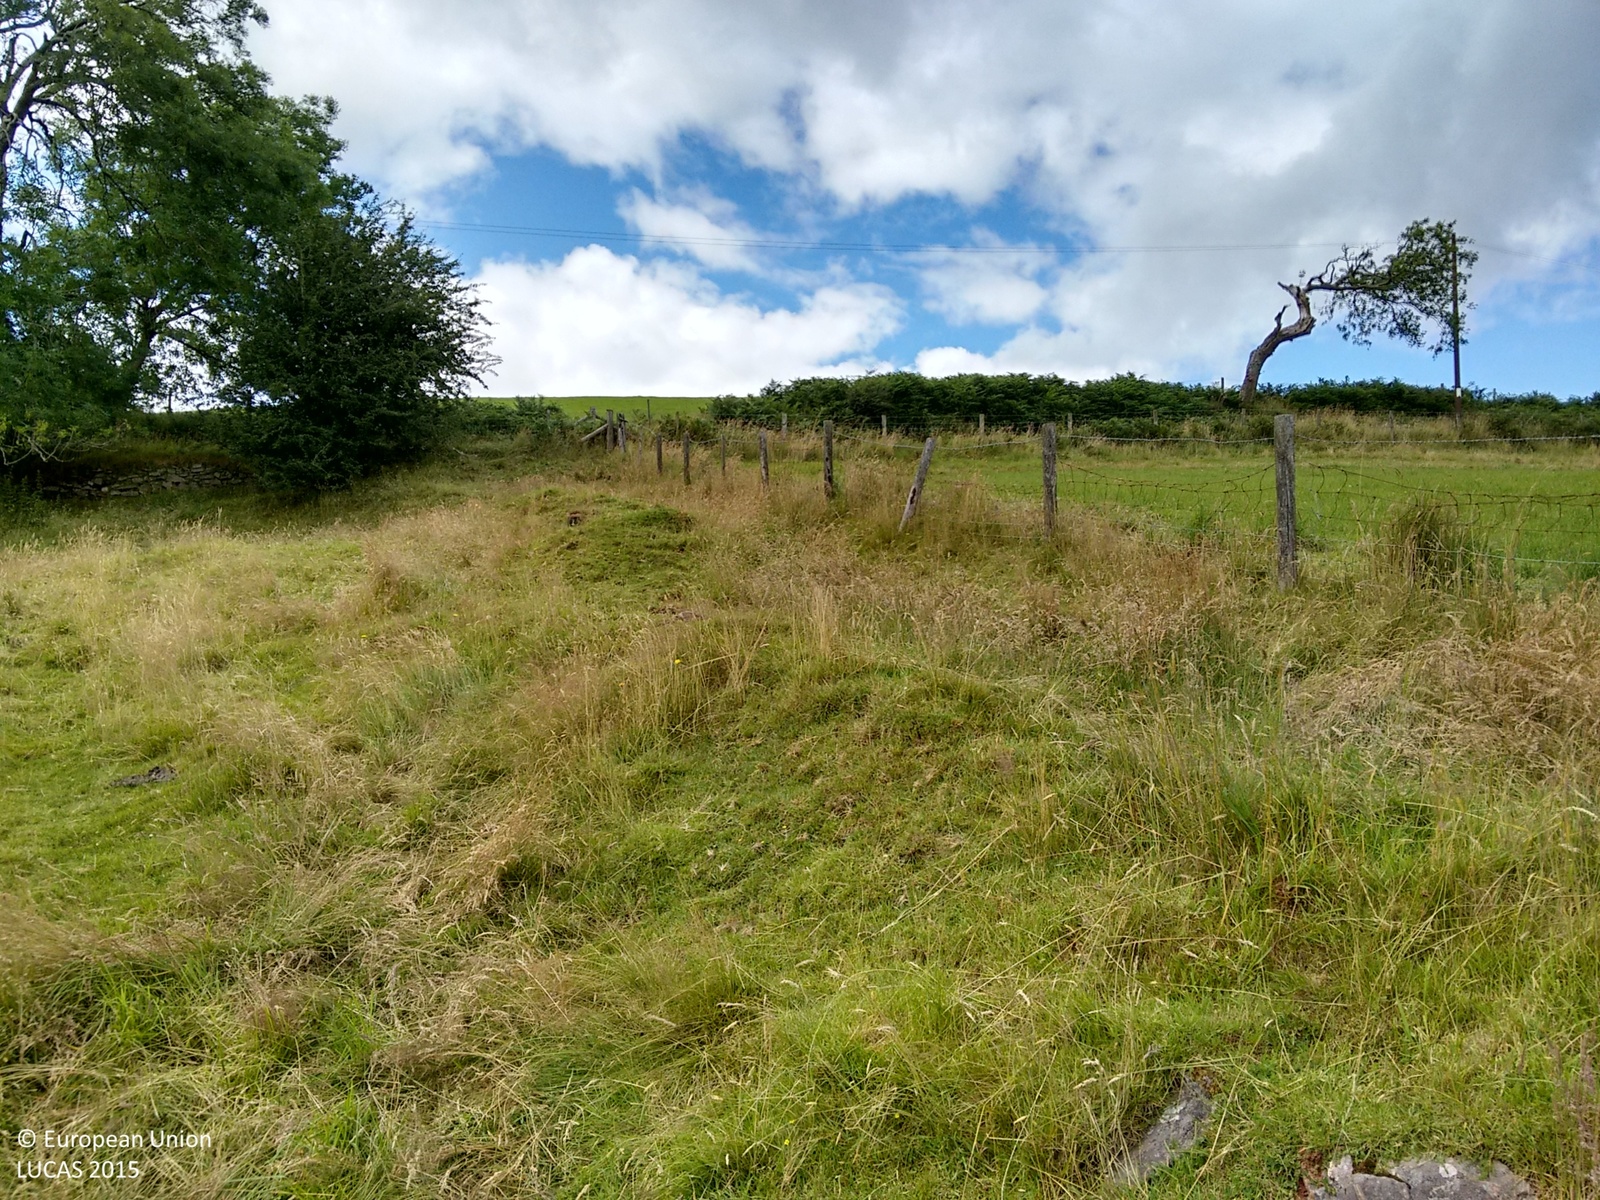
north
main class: Grassland
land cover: Grassland without tree/shrub cover
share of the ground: > 75 %
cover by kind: herbaceous plants 100 %
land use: Agriculture (excluding fallow land and kitchen gardens)
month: July
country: GB
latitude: 51.8854
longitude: -3.8798
